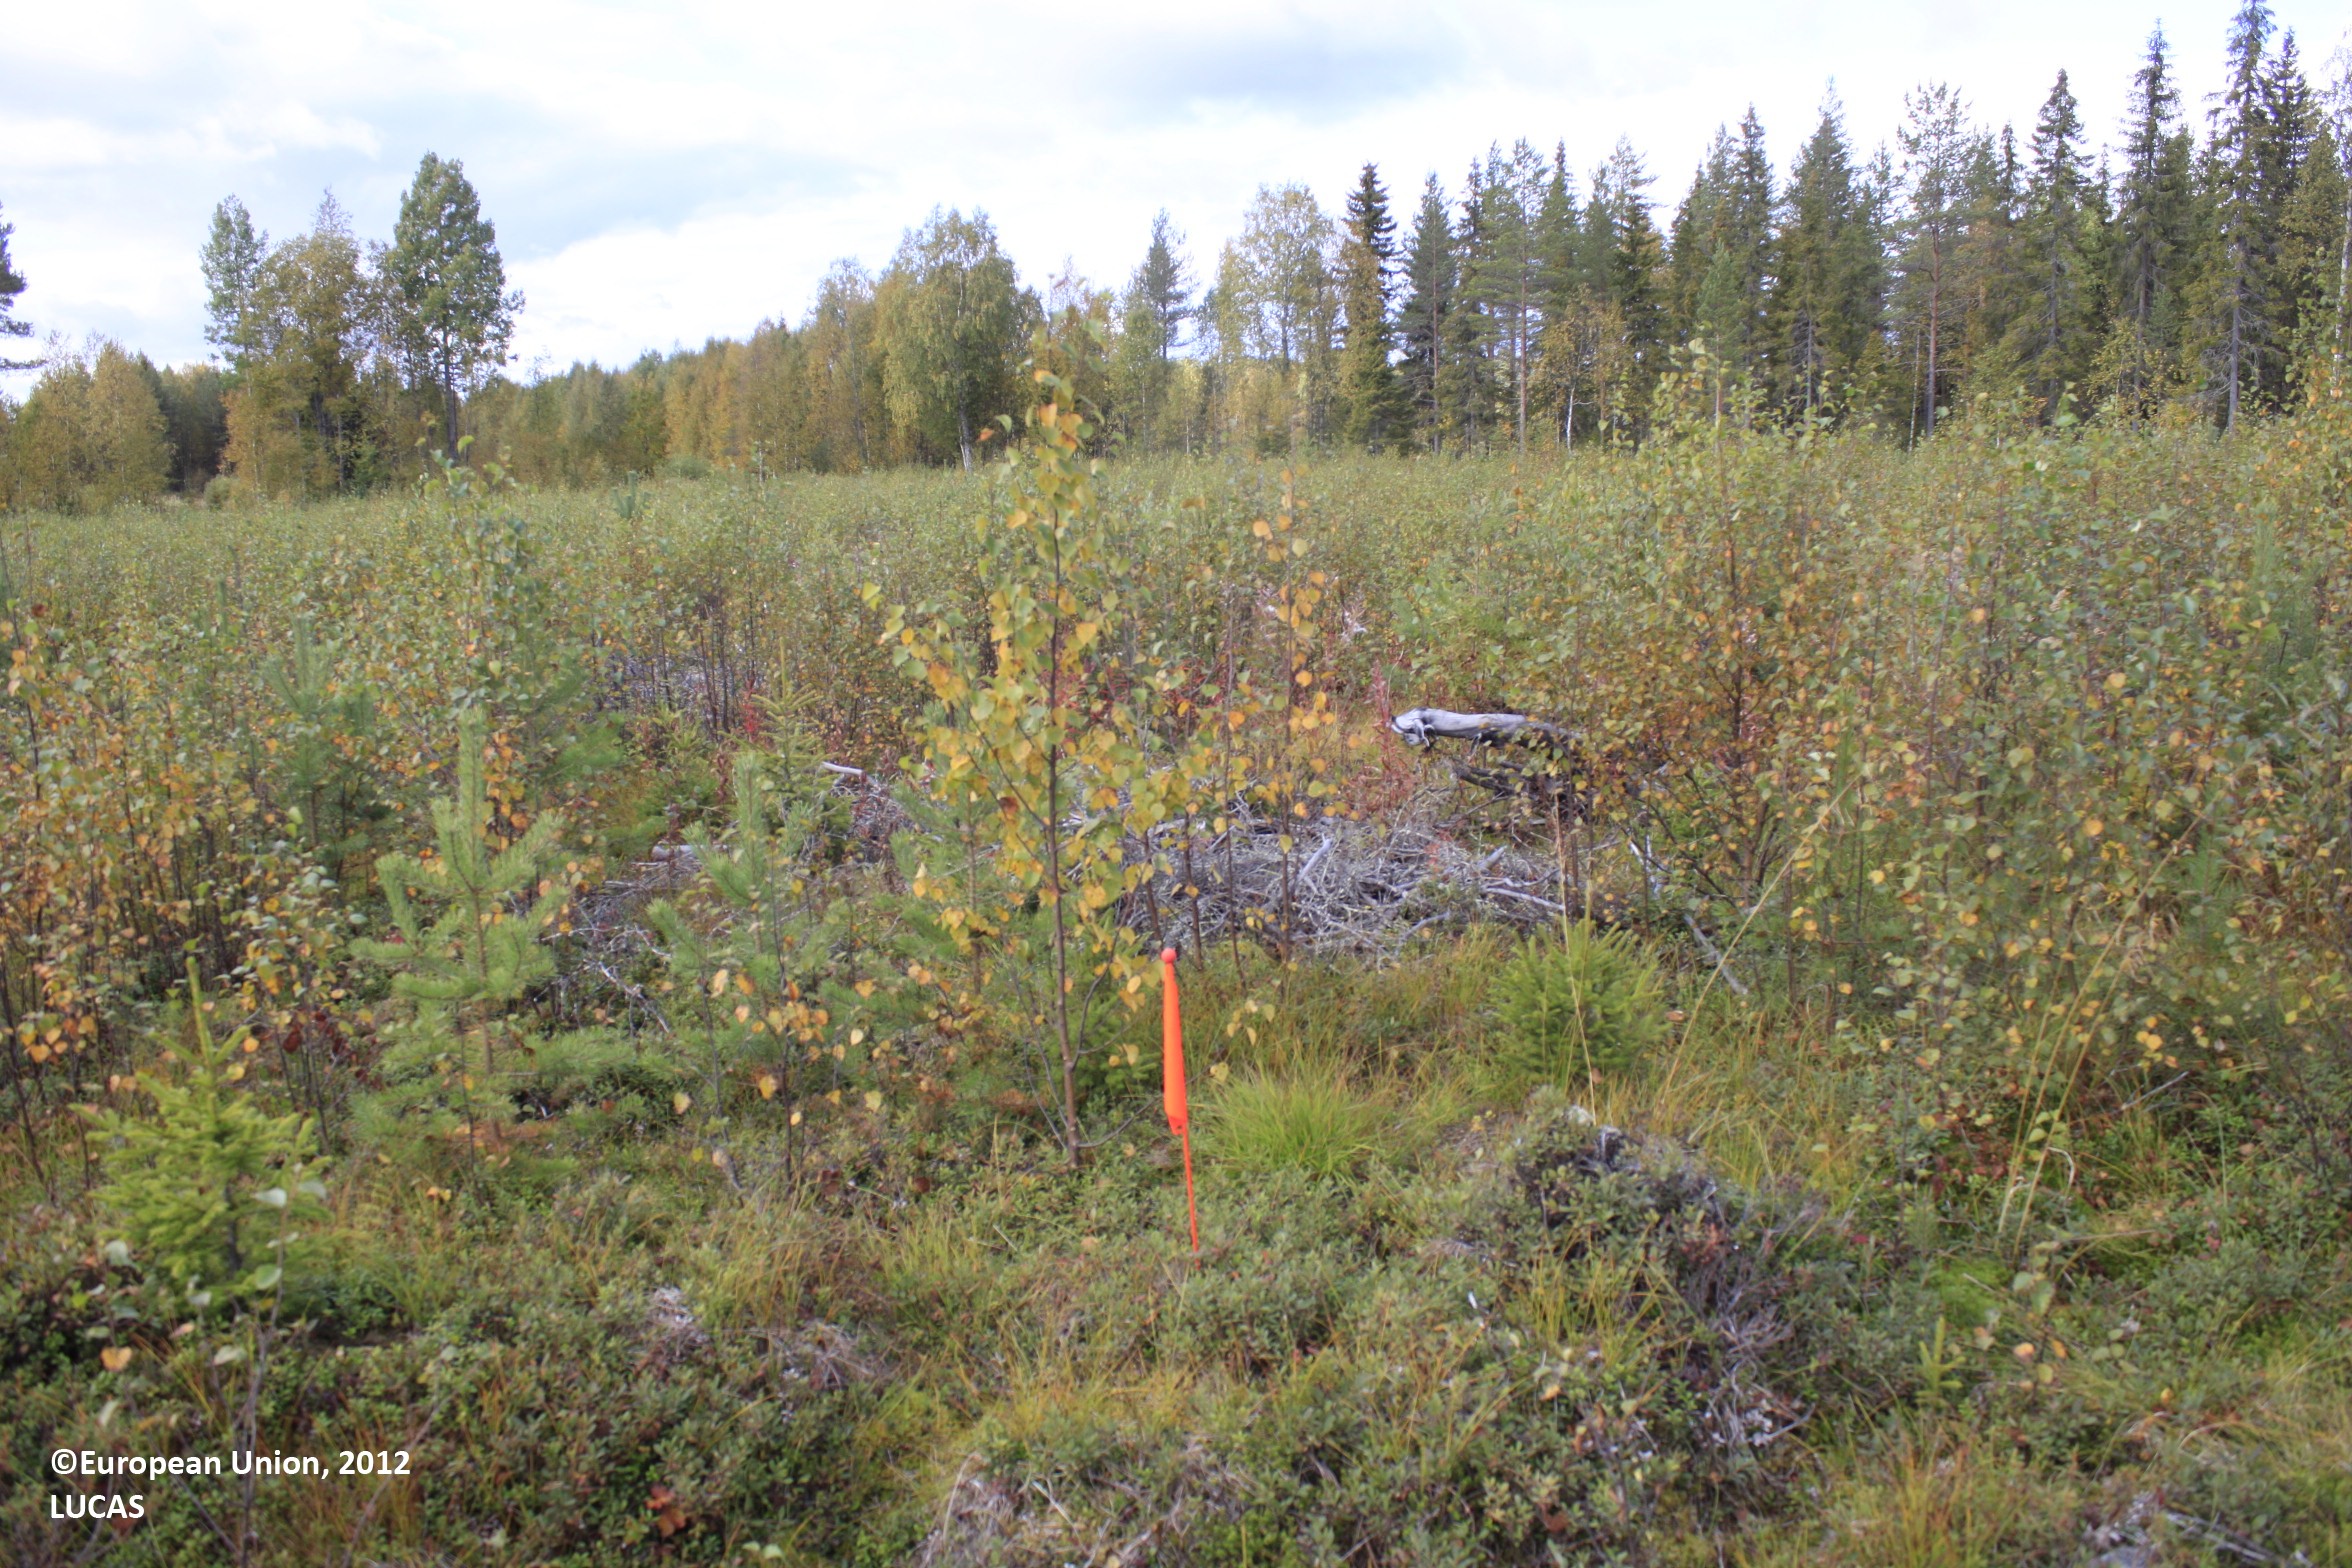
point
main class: Woodland
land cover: Broadleaved woodland
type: boreal forest
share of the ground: 25 - 50 %
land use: Forestry
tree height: < 5 m
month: September
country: FI
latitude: 65.6496
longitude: 26.5992
